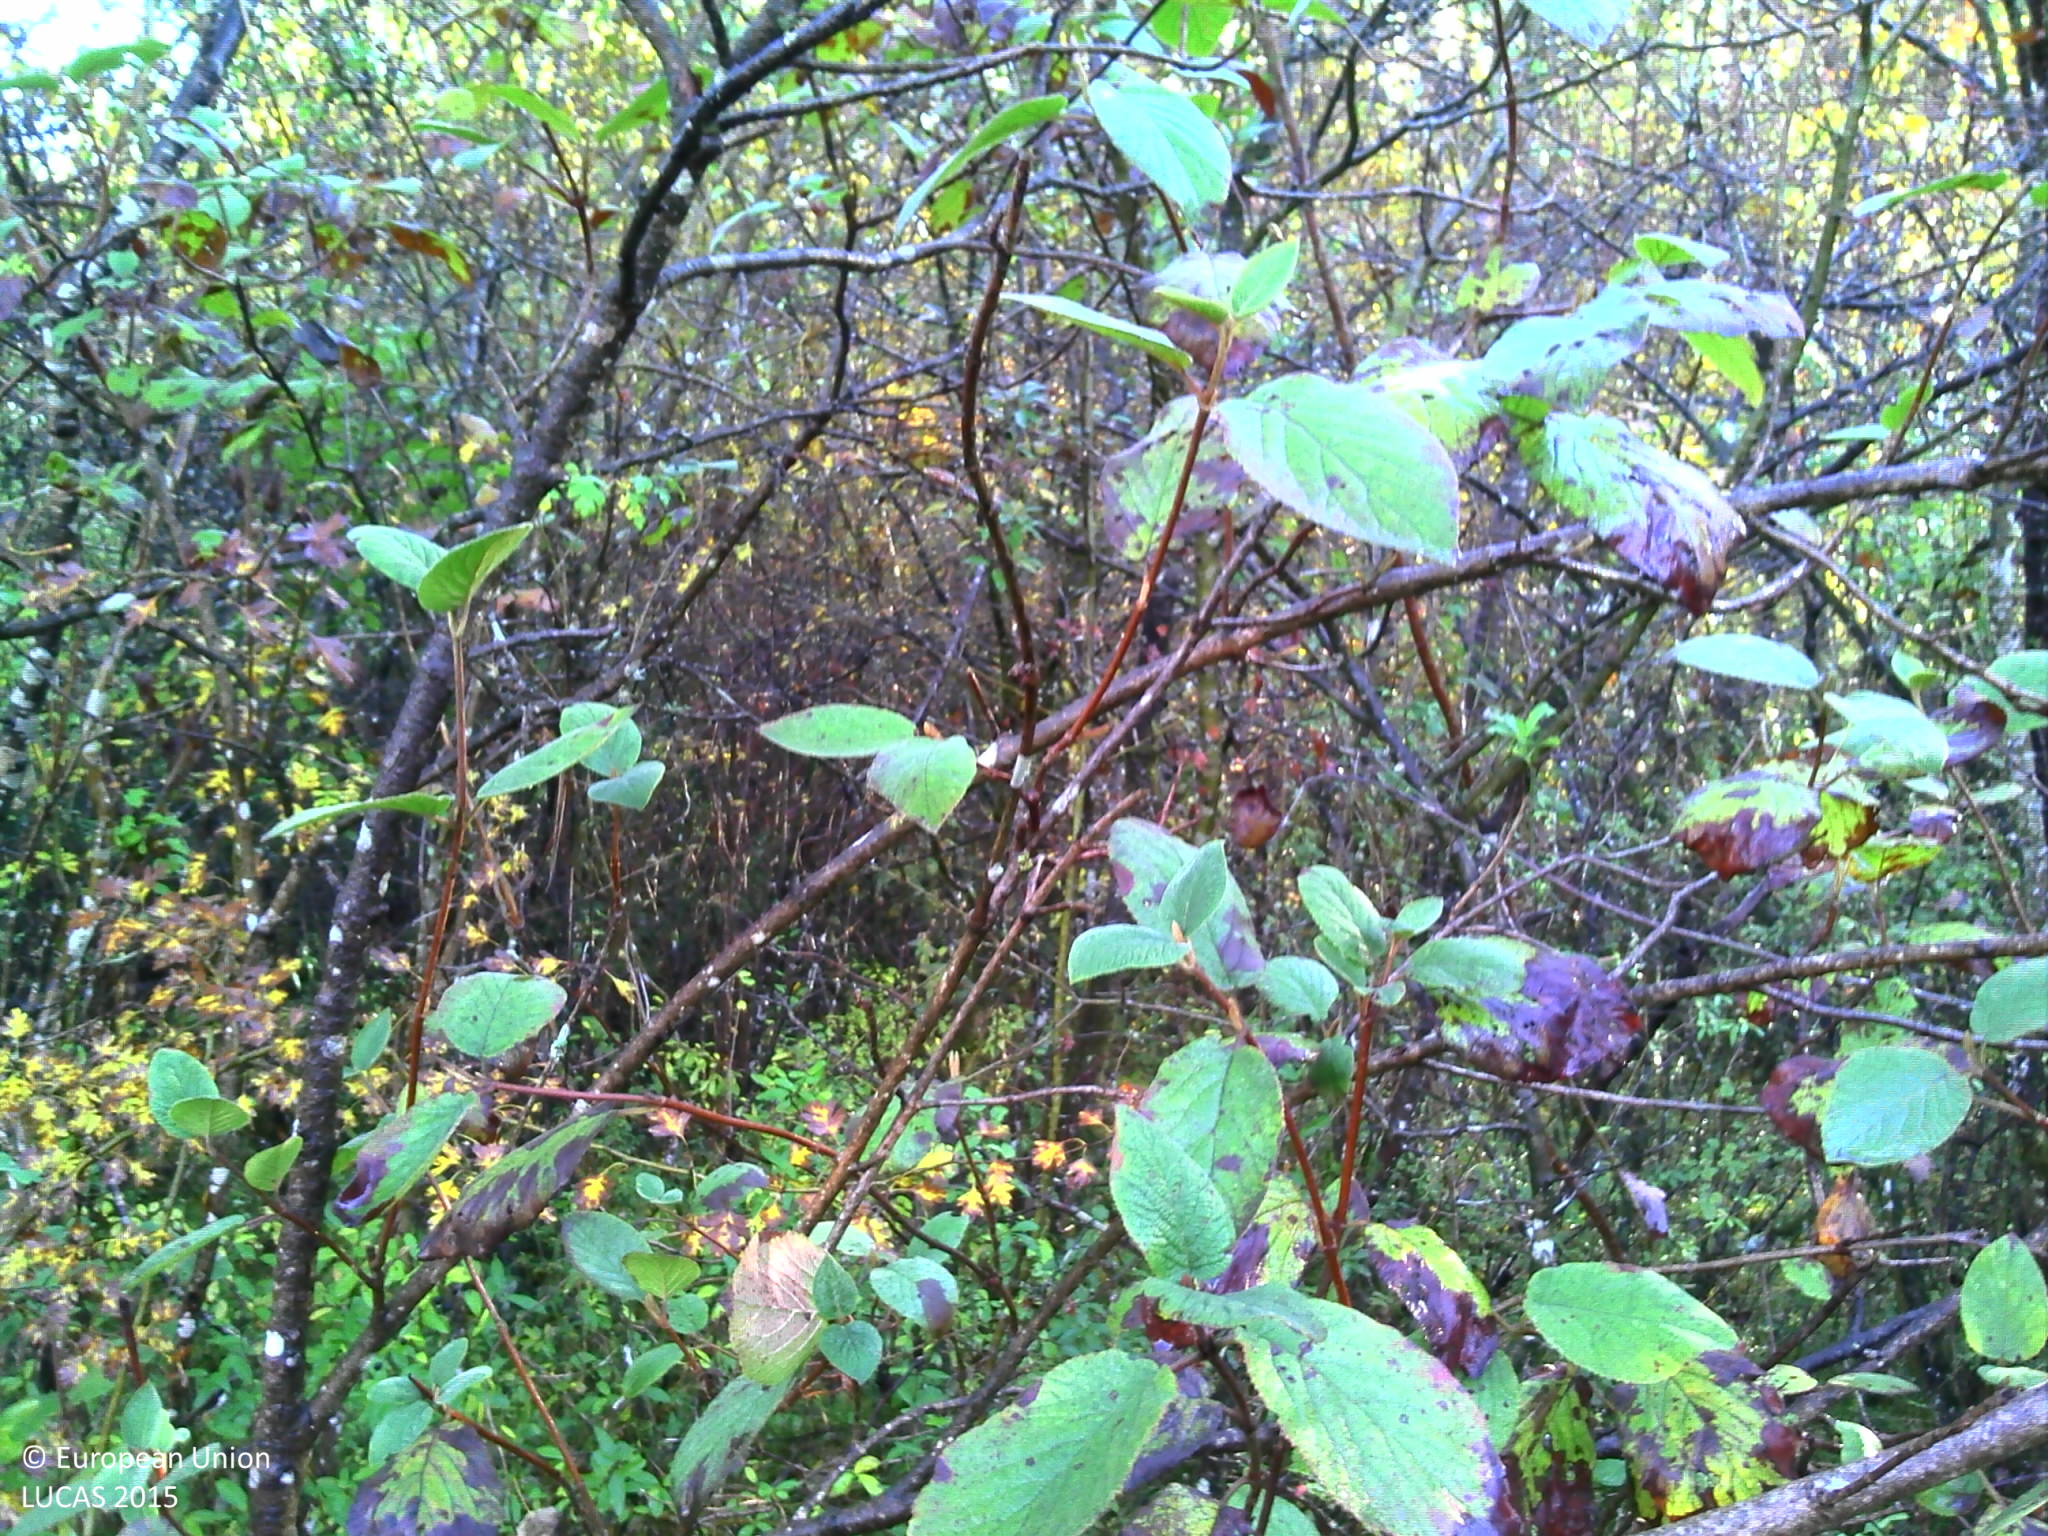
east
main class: Shrubland
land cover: Shrubland with sparse tree cover
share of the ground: > 75 %
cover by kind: shrubs 80 %, herbaceous plants 10 %, broadleaved forest trees 5 %, lichens and mosses 5 %
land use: Agriculture (excluding fallow land and kitchen gardens)
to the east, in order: Shrubland with sparse tree cover; Broadleaved woodland; Tracks; Fences; Broadleaved woodland; Arable land (only in case pi)
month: October
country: FR
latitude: 45.9949
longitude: 5.2909
